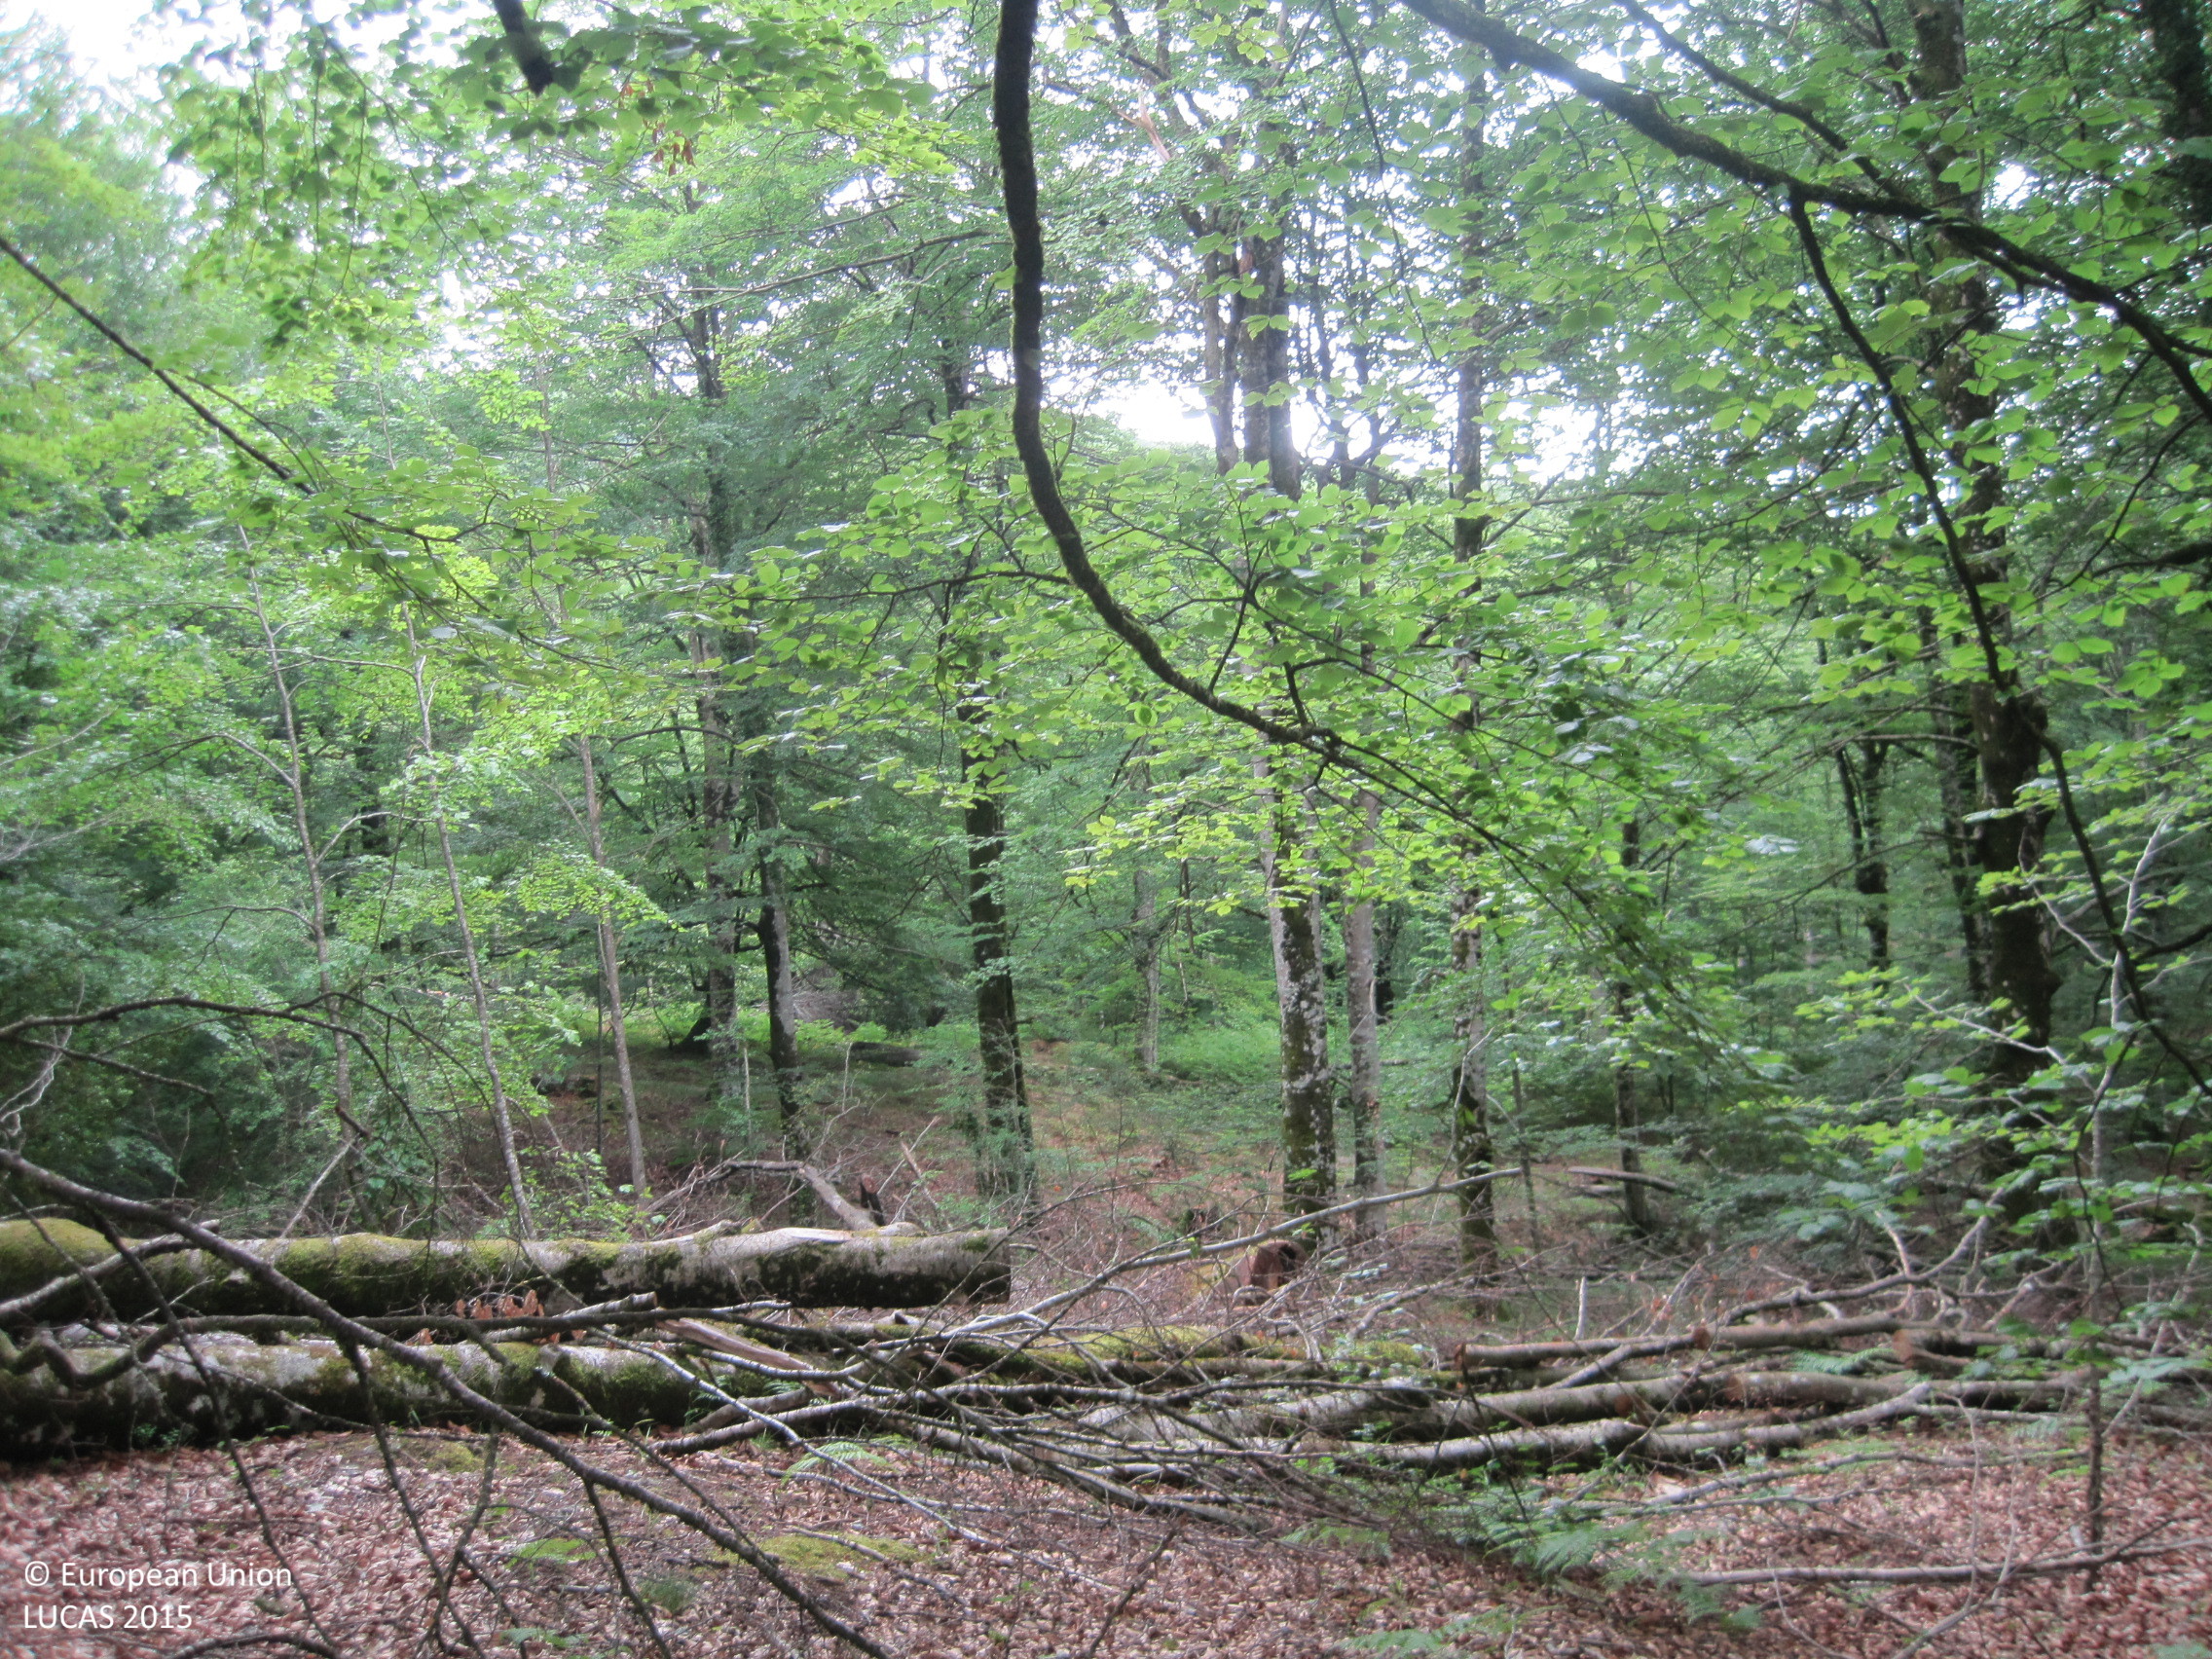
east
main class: Woodland
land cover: Broadleaved woodland
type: beech forest
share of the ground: > 75 %
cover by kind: broadleaved forest trees 100 %
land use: Forestry
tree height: > 5 m
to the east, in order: Broadleaved woodland; Rivers and streams; Broadleaved woodland; Tracks; Broadleaved woodland; Rivers and streams; Broadleaved woodland; Rivers and streams; Broadleaved woodland; Tracks; Broadleaved woodland
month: June
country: ES
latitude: 42.9333
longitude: -2.2142
